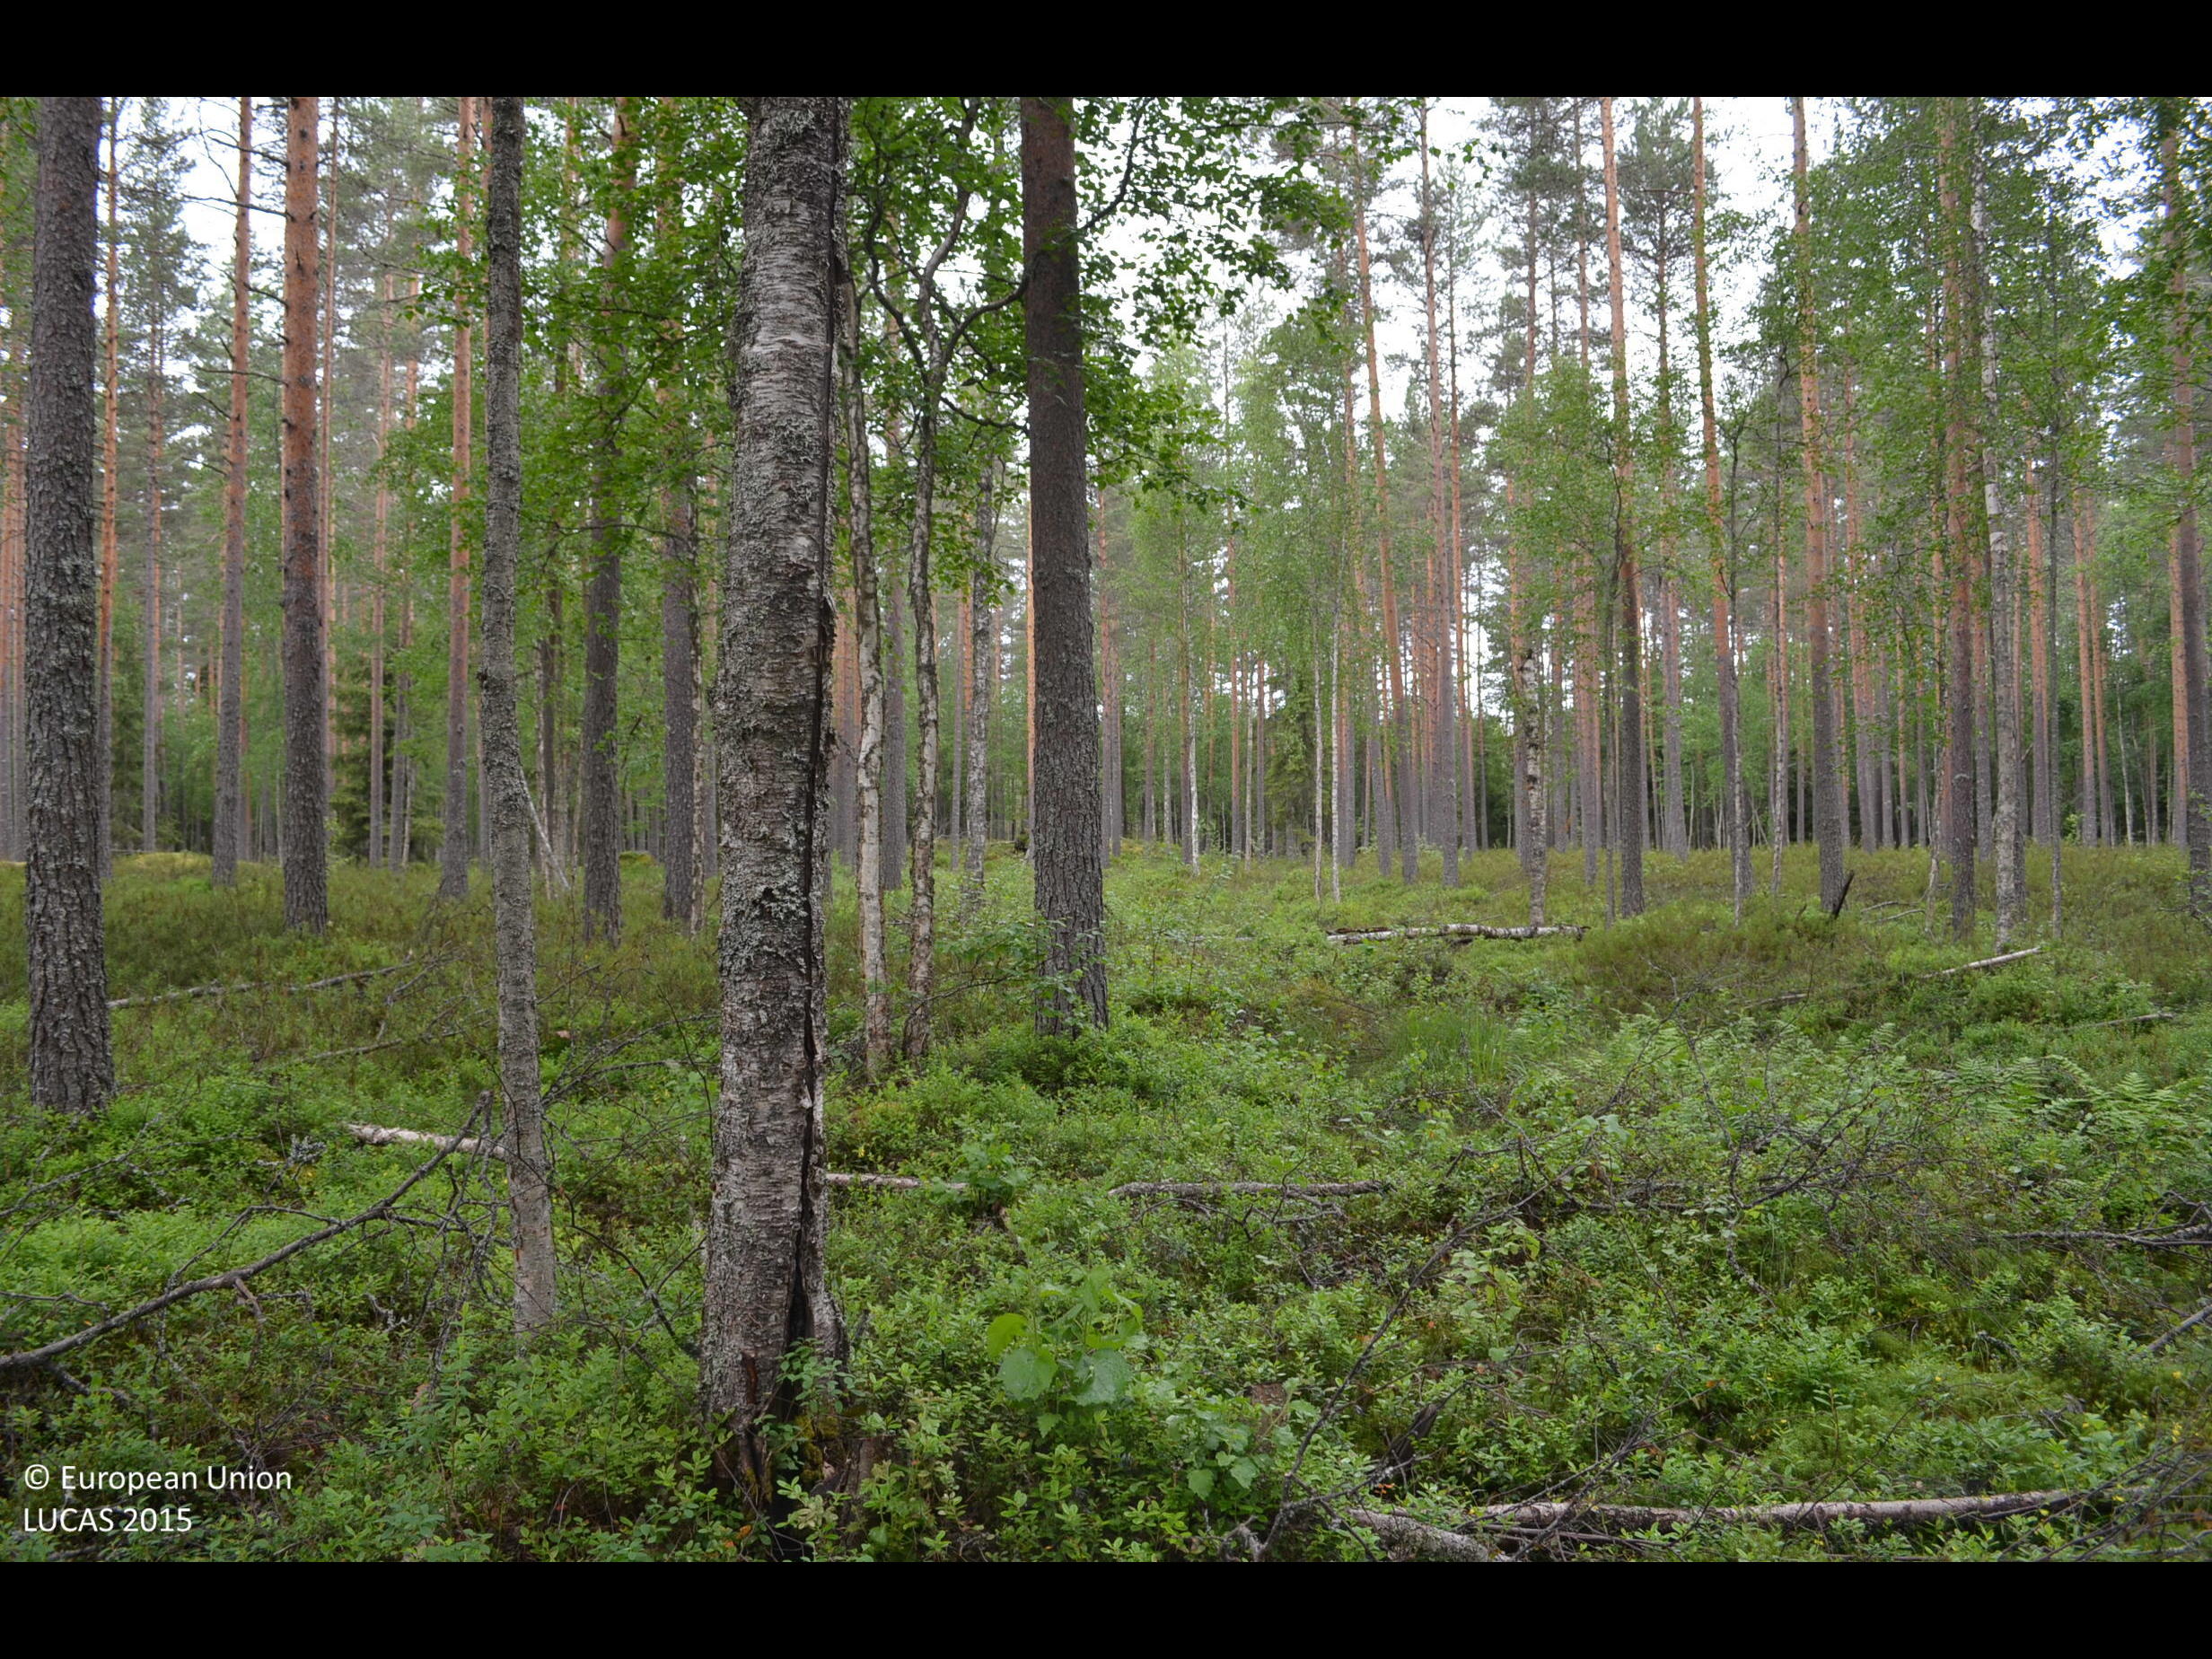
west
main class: Woodland
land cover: Pine dominated mixed woodland
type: boreal forest
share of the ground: > 75 %
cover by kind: coniferous forest trees 55 %, shrubs 25 %, broadleaved forest trees 20 %
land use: Forestry
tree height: > 5 m
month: July
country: FI
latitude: 62.2511
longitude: 23.5704
